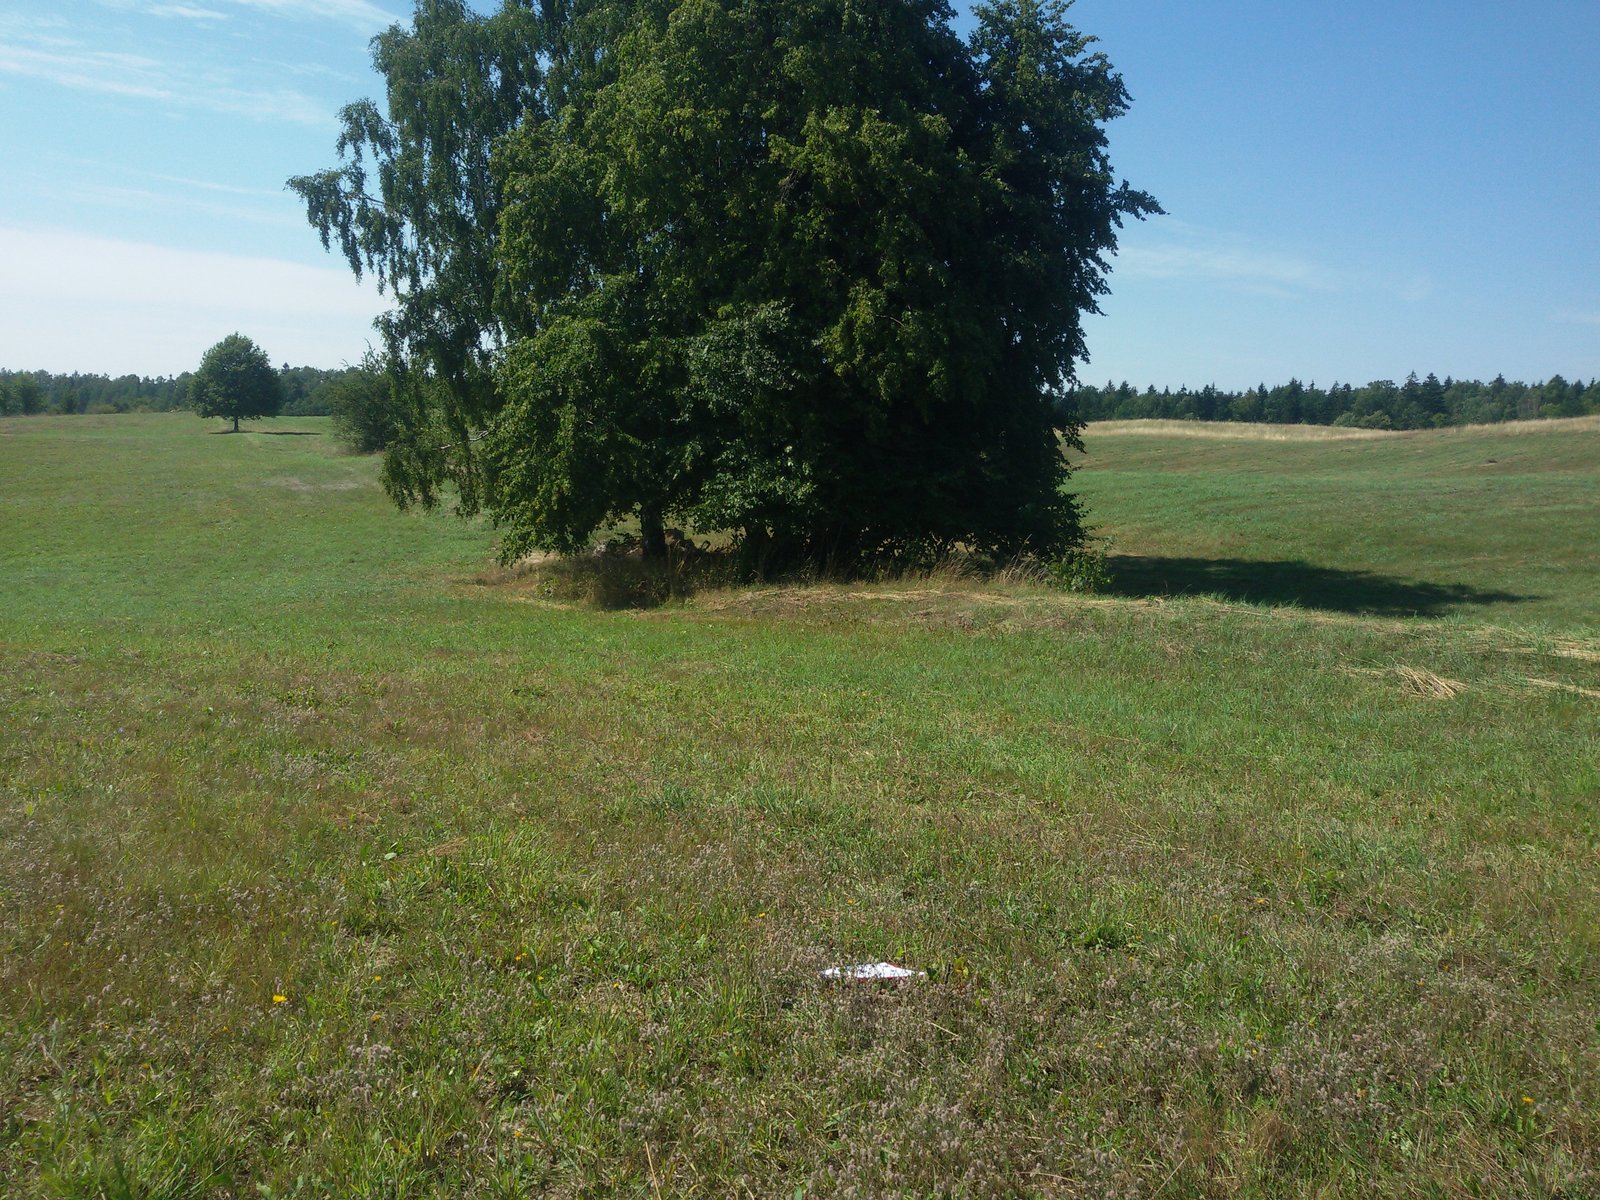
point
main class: Grassland
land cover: Grassland without tree/shrub cover
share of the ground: > 75 %
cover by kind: herbaceous plants 100 %
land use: Agriculture (excluding fallow land and kitchen gardens)
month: August
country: PL
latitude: 53.8852
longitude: 21.1354
